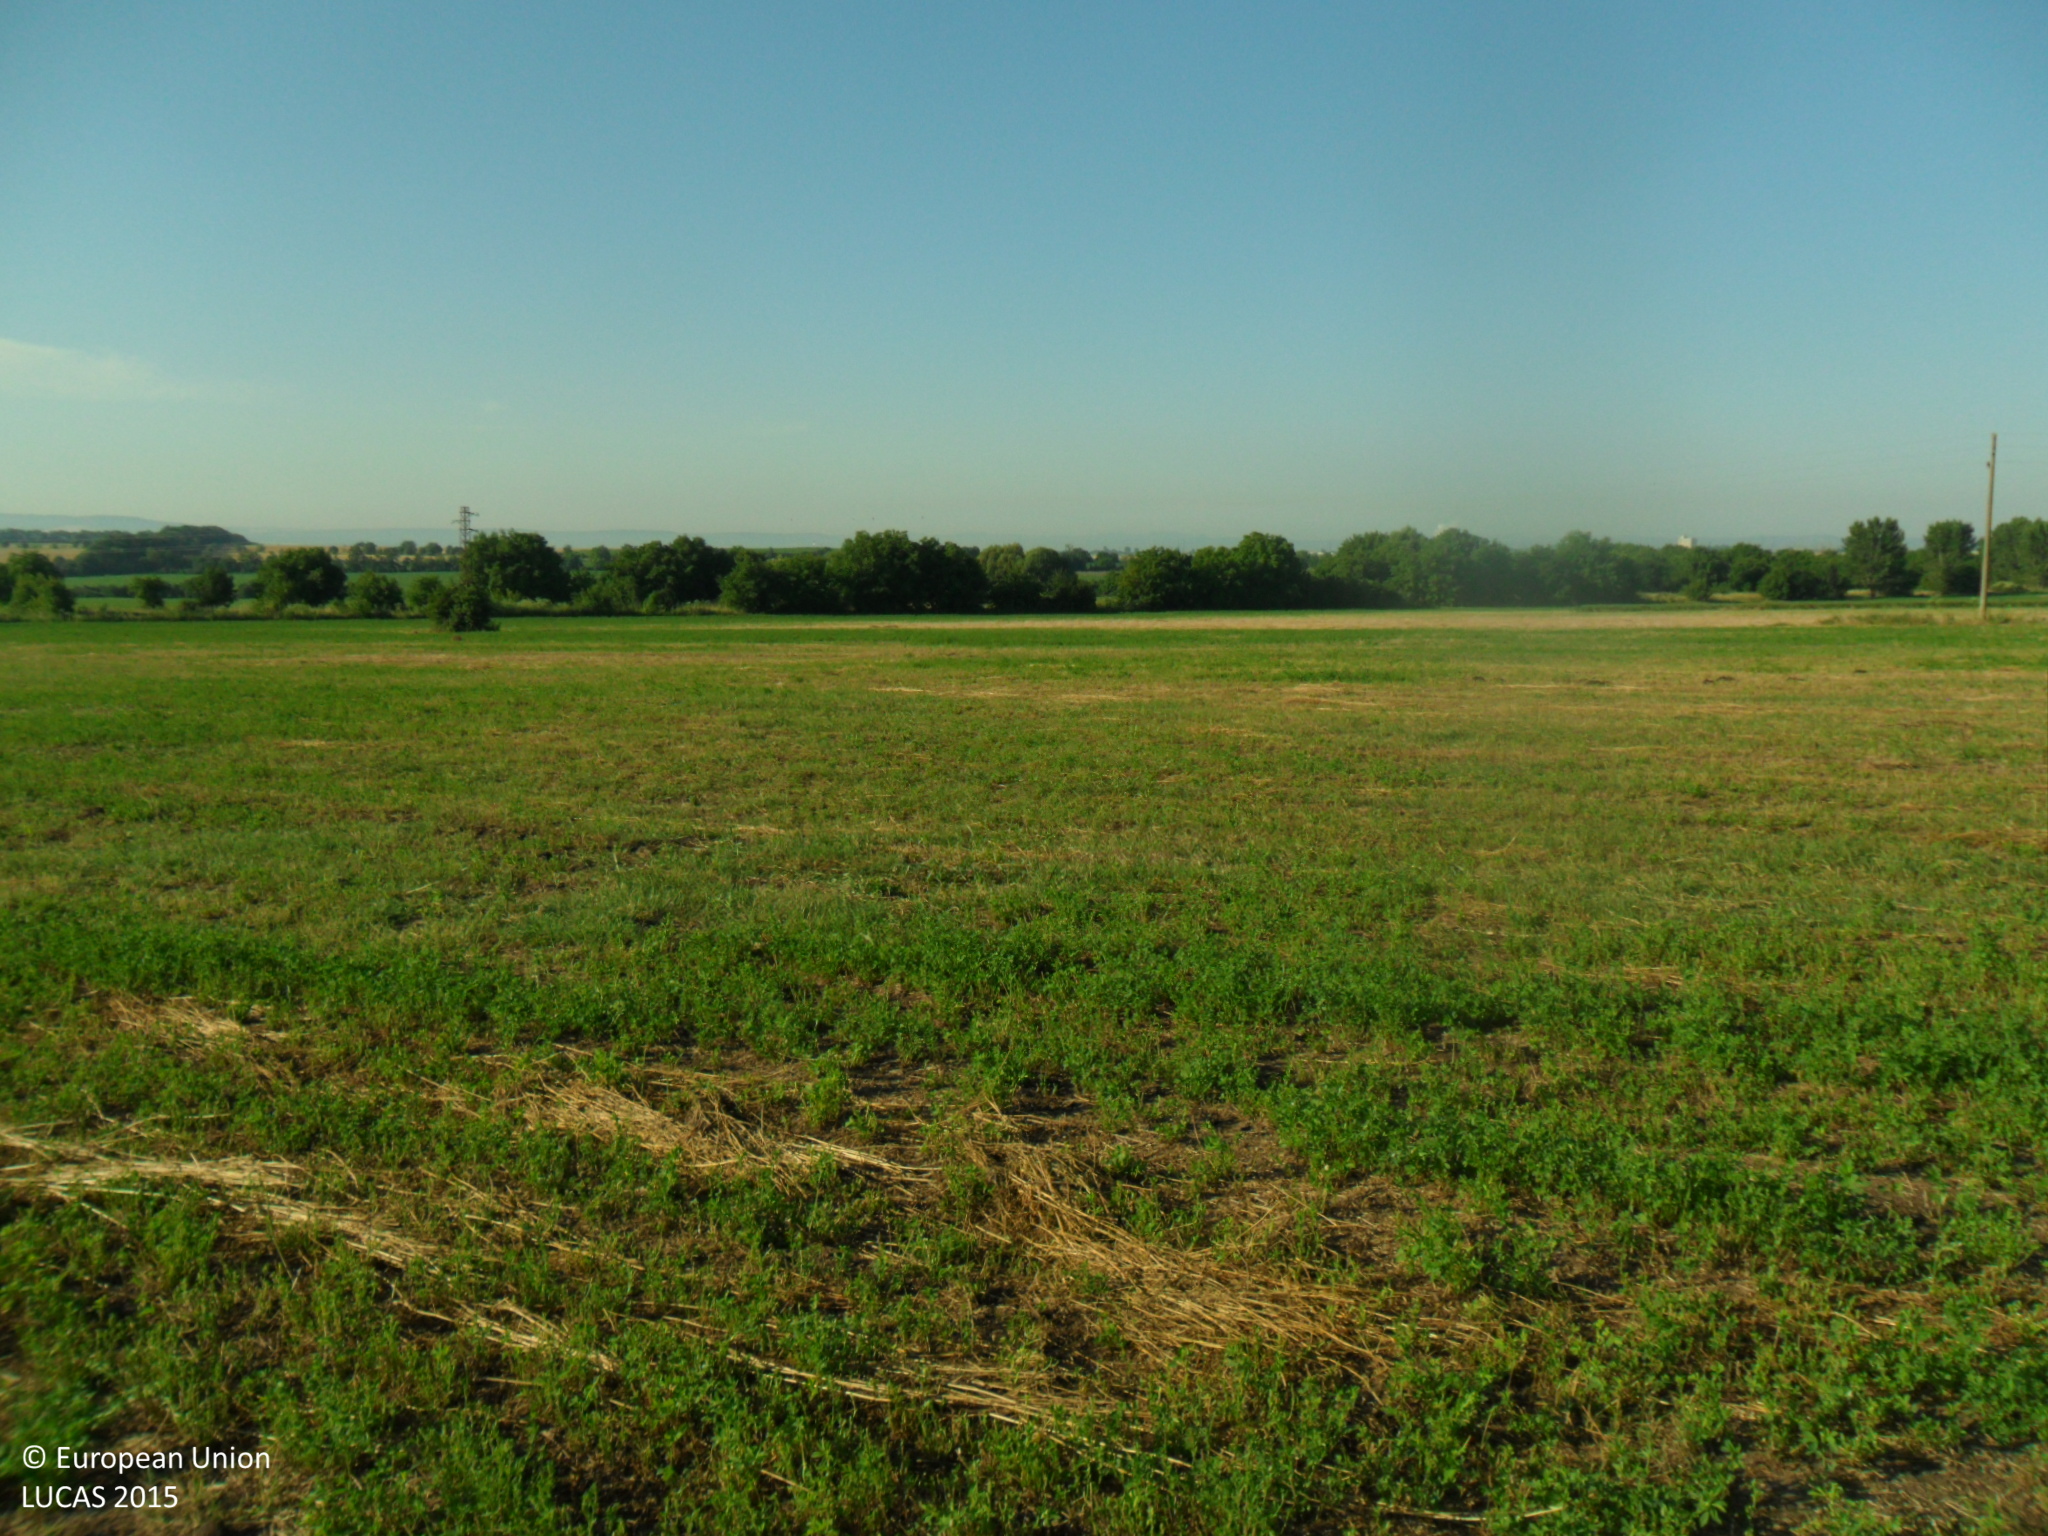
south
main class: Cropland
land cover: Lucerne
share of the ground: > 75 %
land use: Agriculture (excluding fallow land and kitchen gardens)
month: June
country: BG
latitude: 43.3141
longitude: 27.0450
